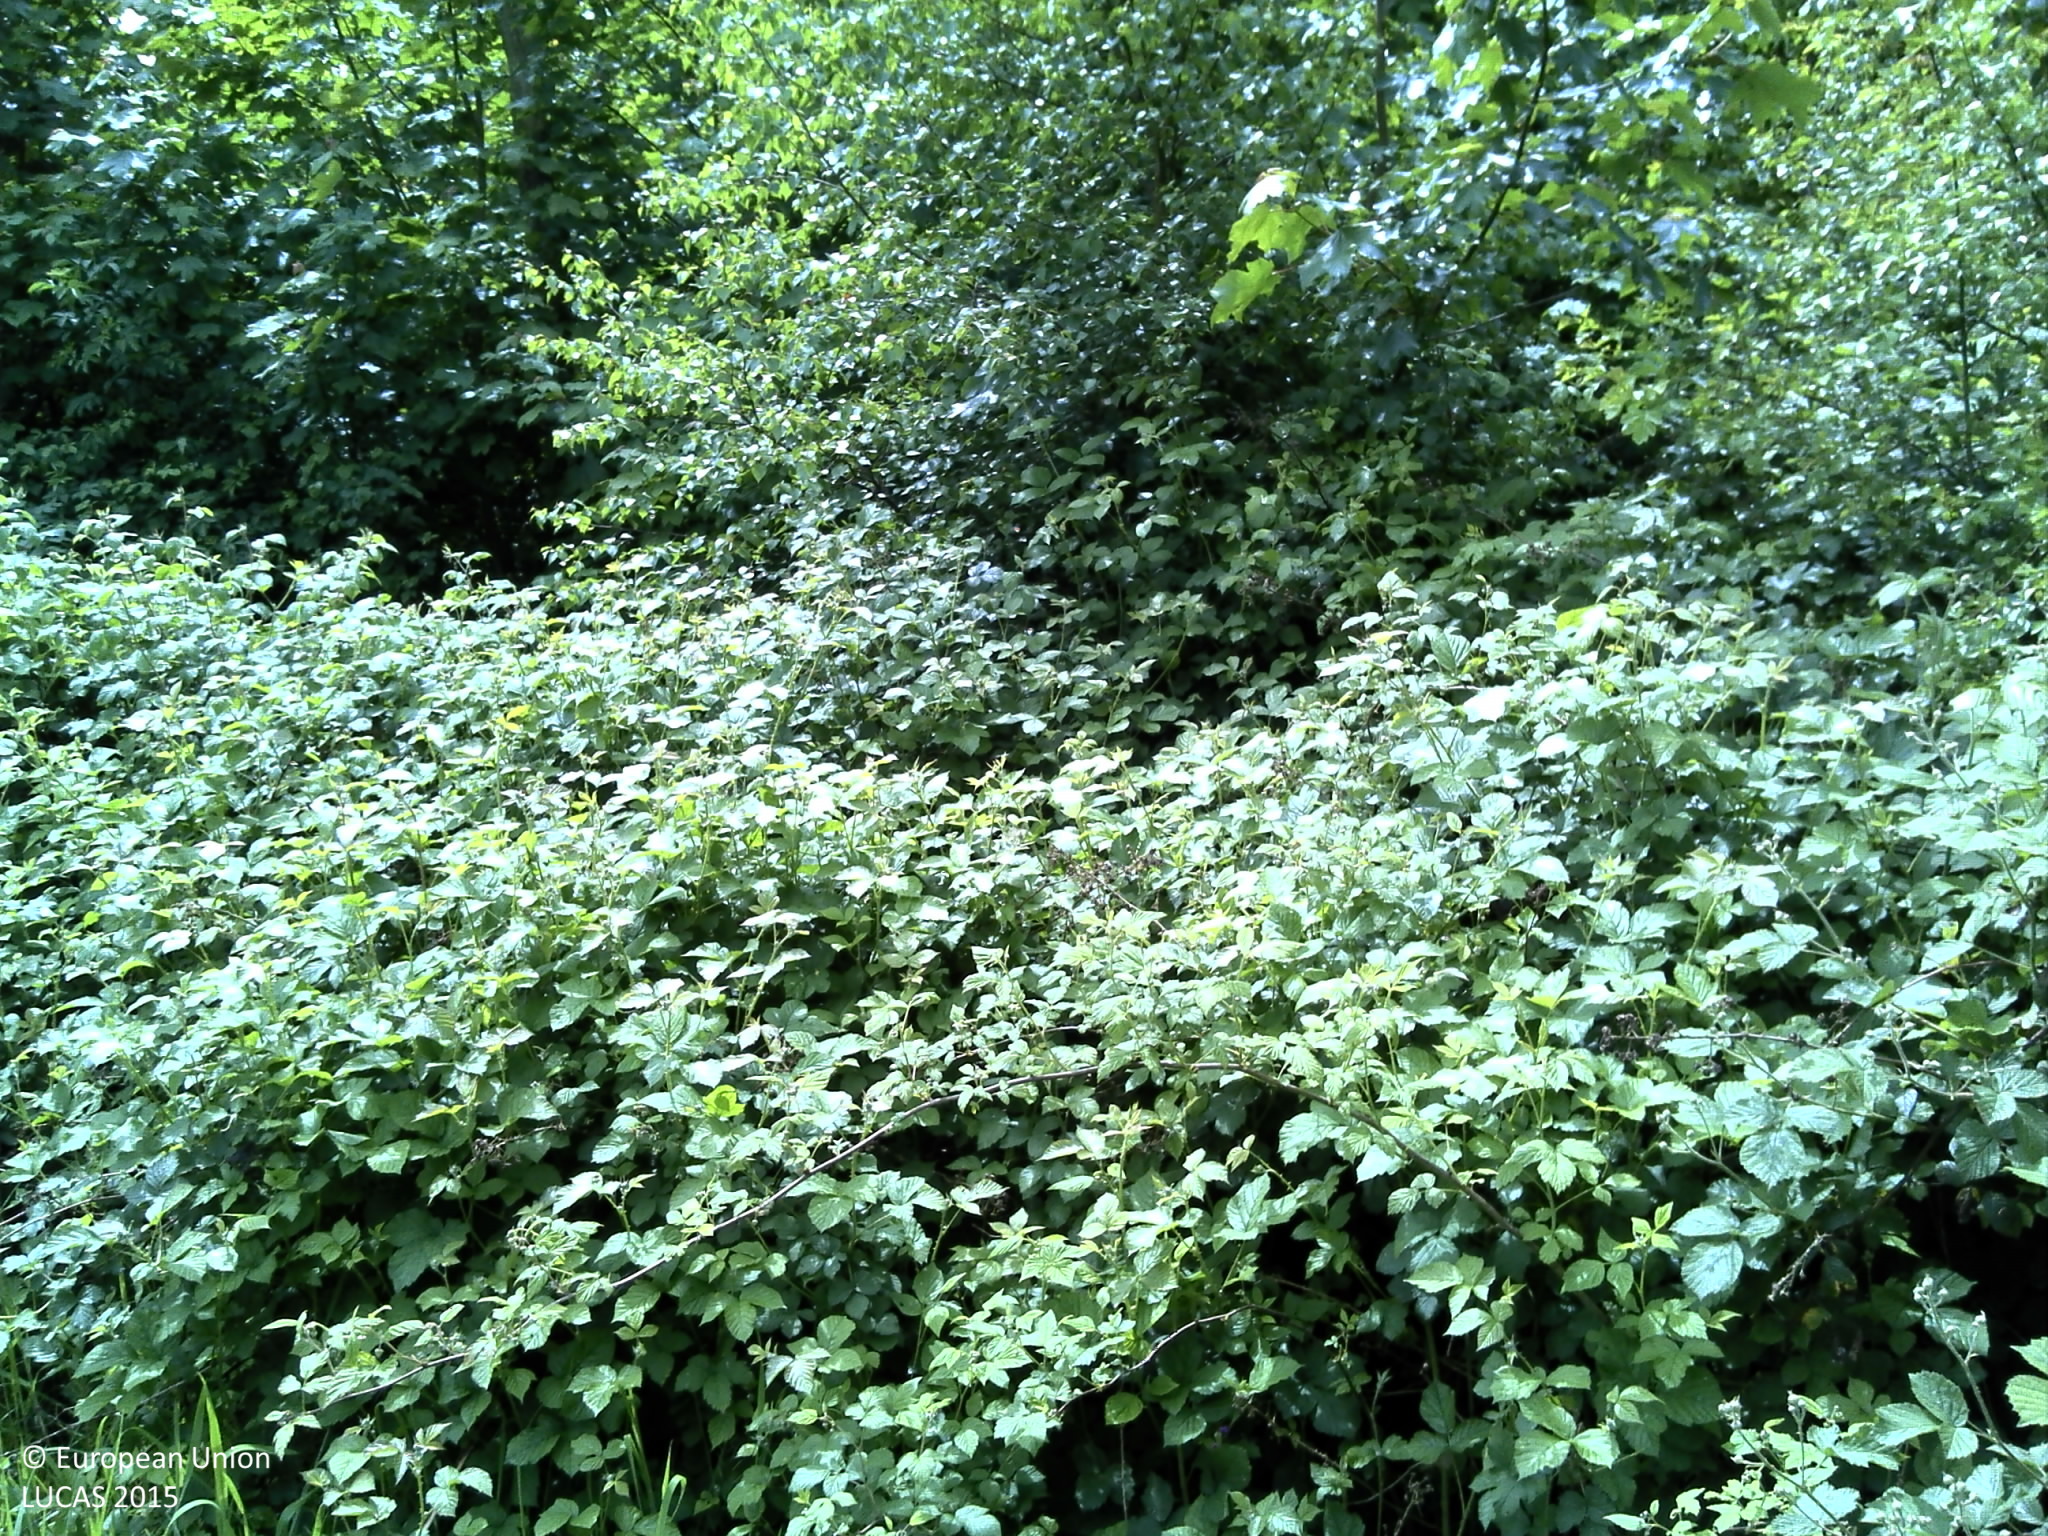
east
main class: Cropland
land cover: Rape and turnip rape
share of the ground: > 75 %
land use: Agriculture (excluding fallow land and kitchen gardens)
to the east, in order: Rape and turnip rape
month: May
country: FR
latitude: 49.5541
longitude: 1.2015
